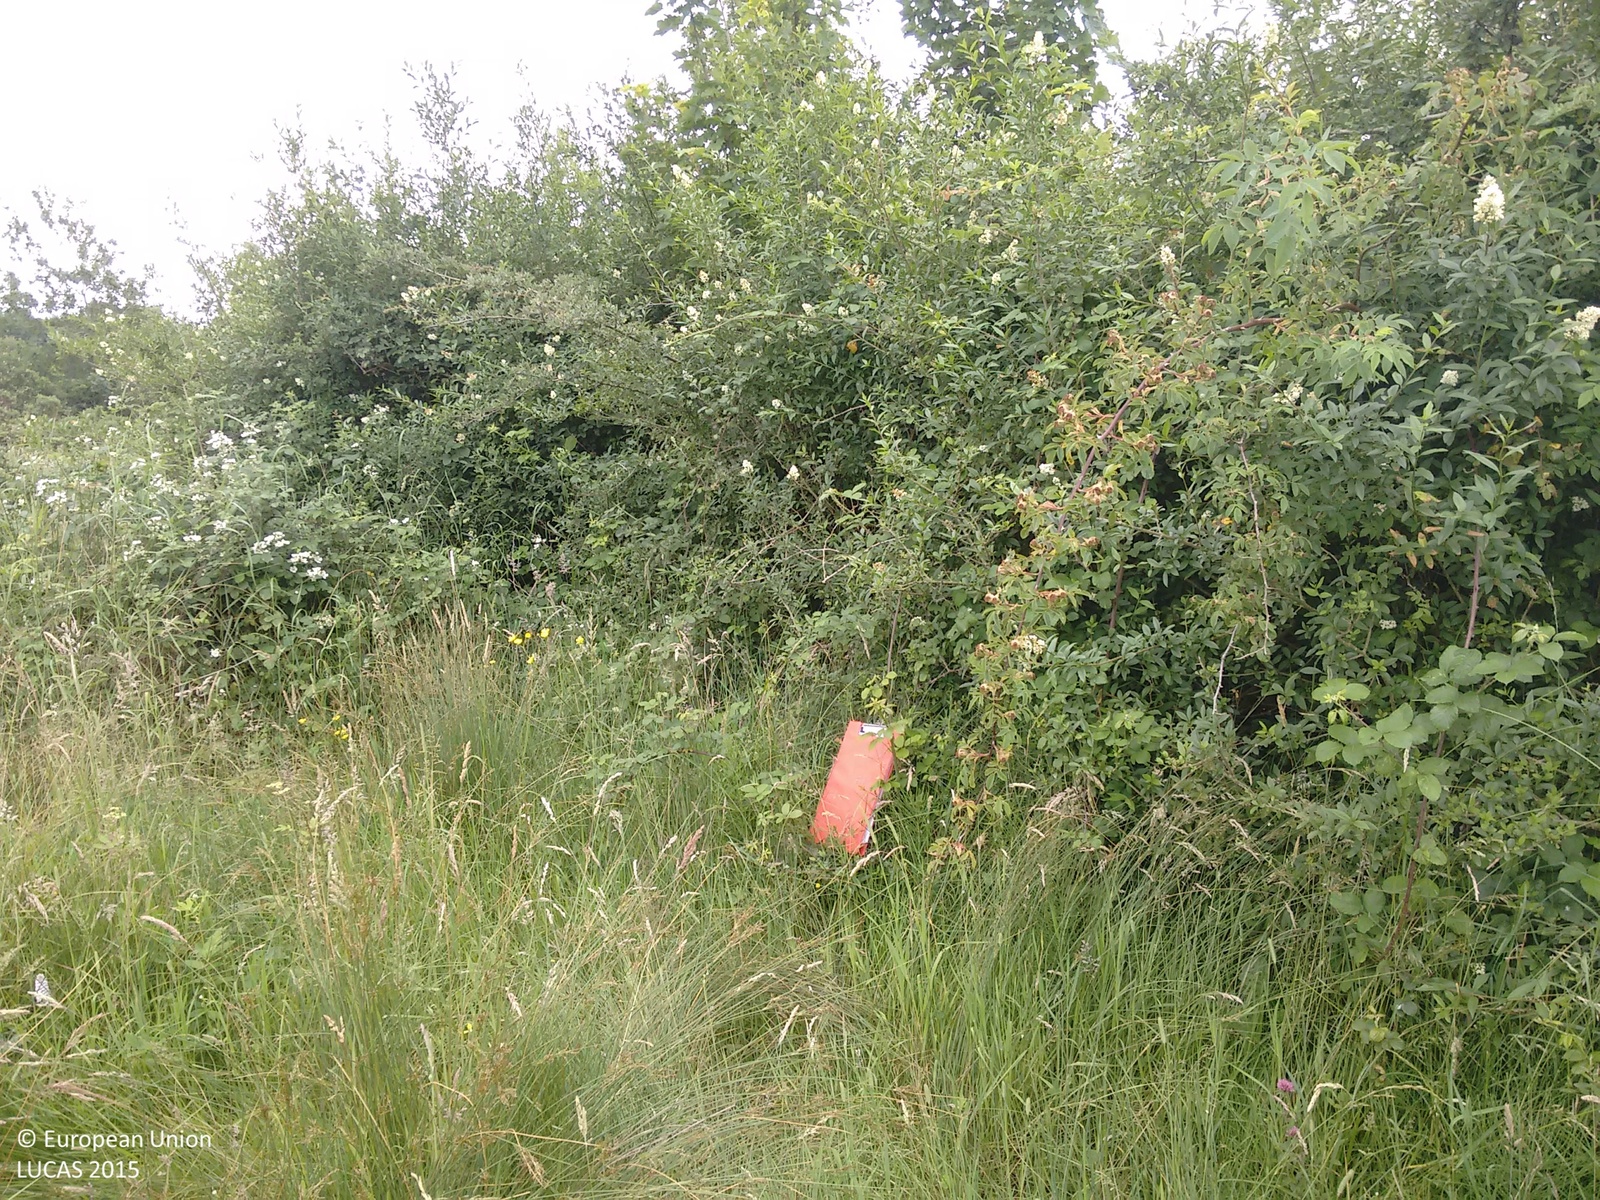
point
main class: Grassland
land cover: Grassland with sparse tree/shrub cover
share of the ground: > 75 %
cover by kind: herbaceous plants 85 %, shrubs 10 %, broadleaved forest trees 5 %
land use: Agriculture (excluding fallow land and kitchen gardens)
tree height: > 5 m
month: July
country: IE
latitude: 53.5111
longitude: -7.7646
